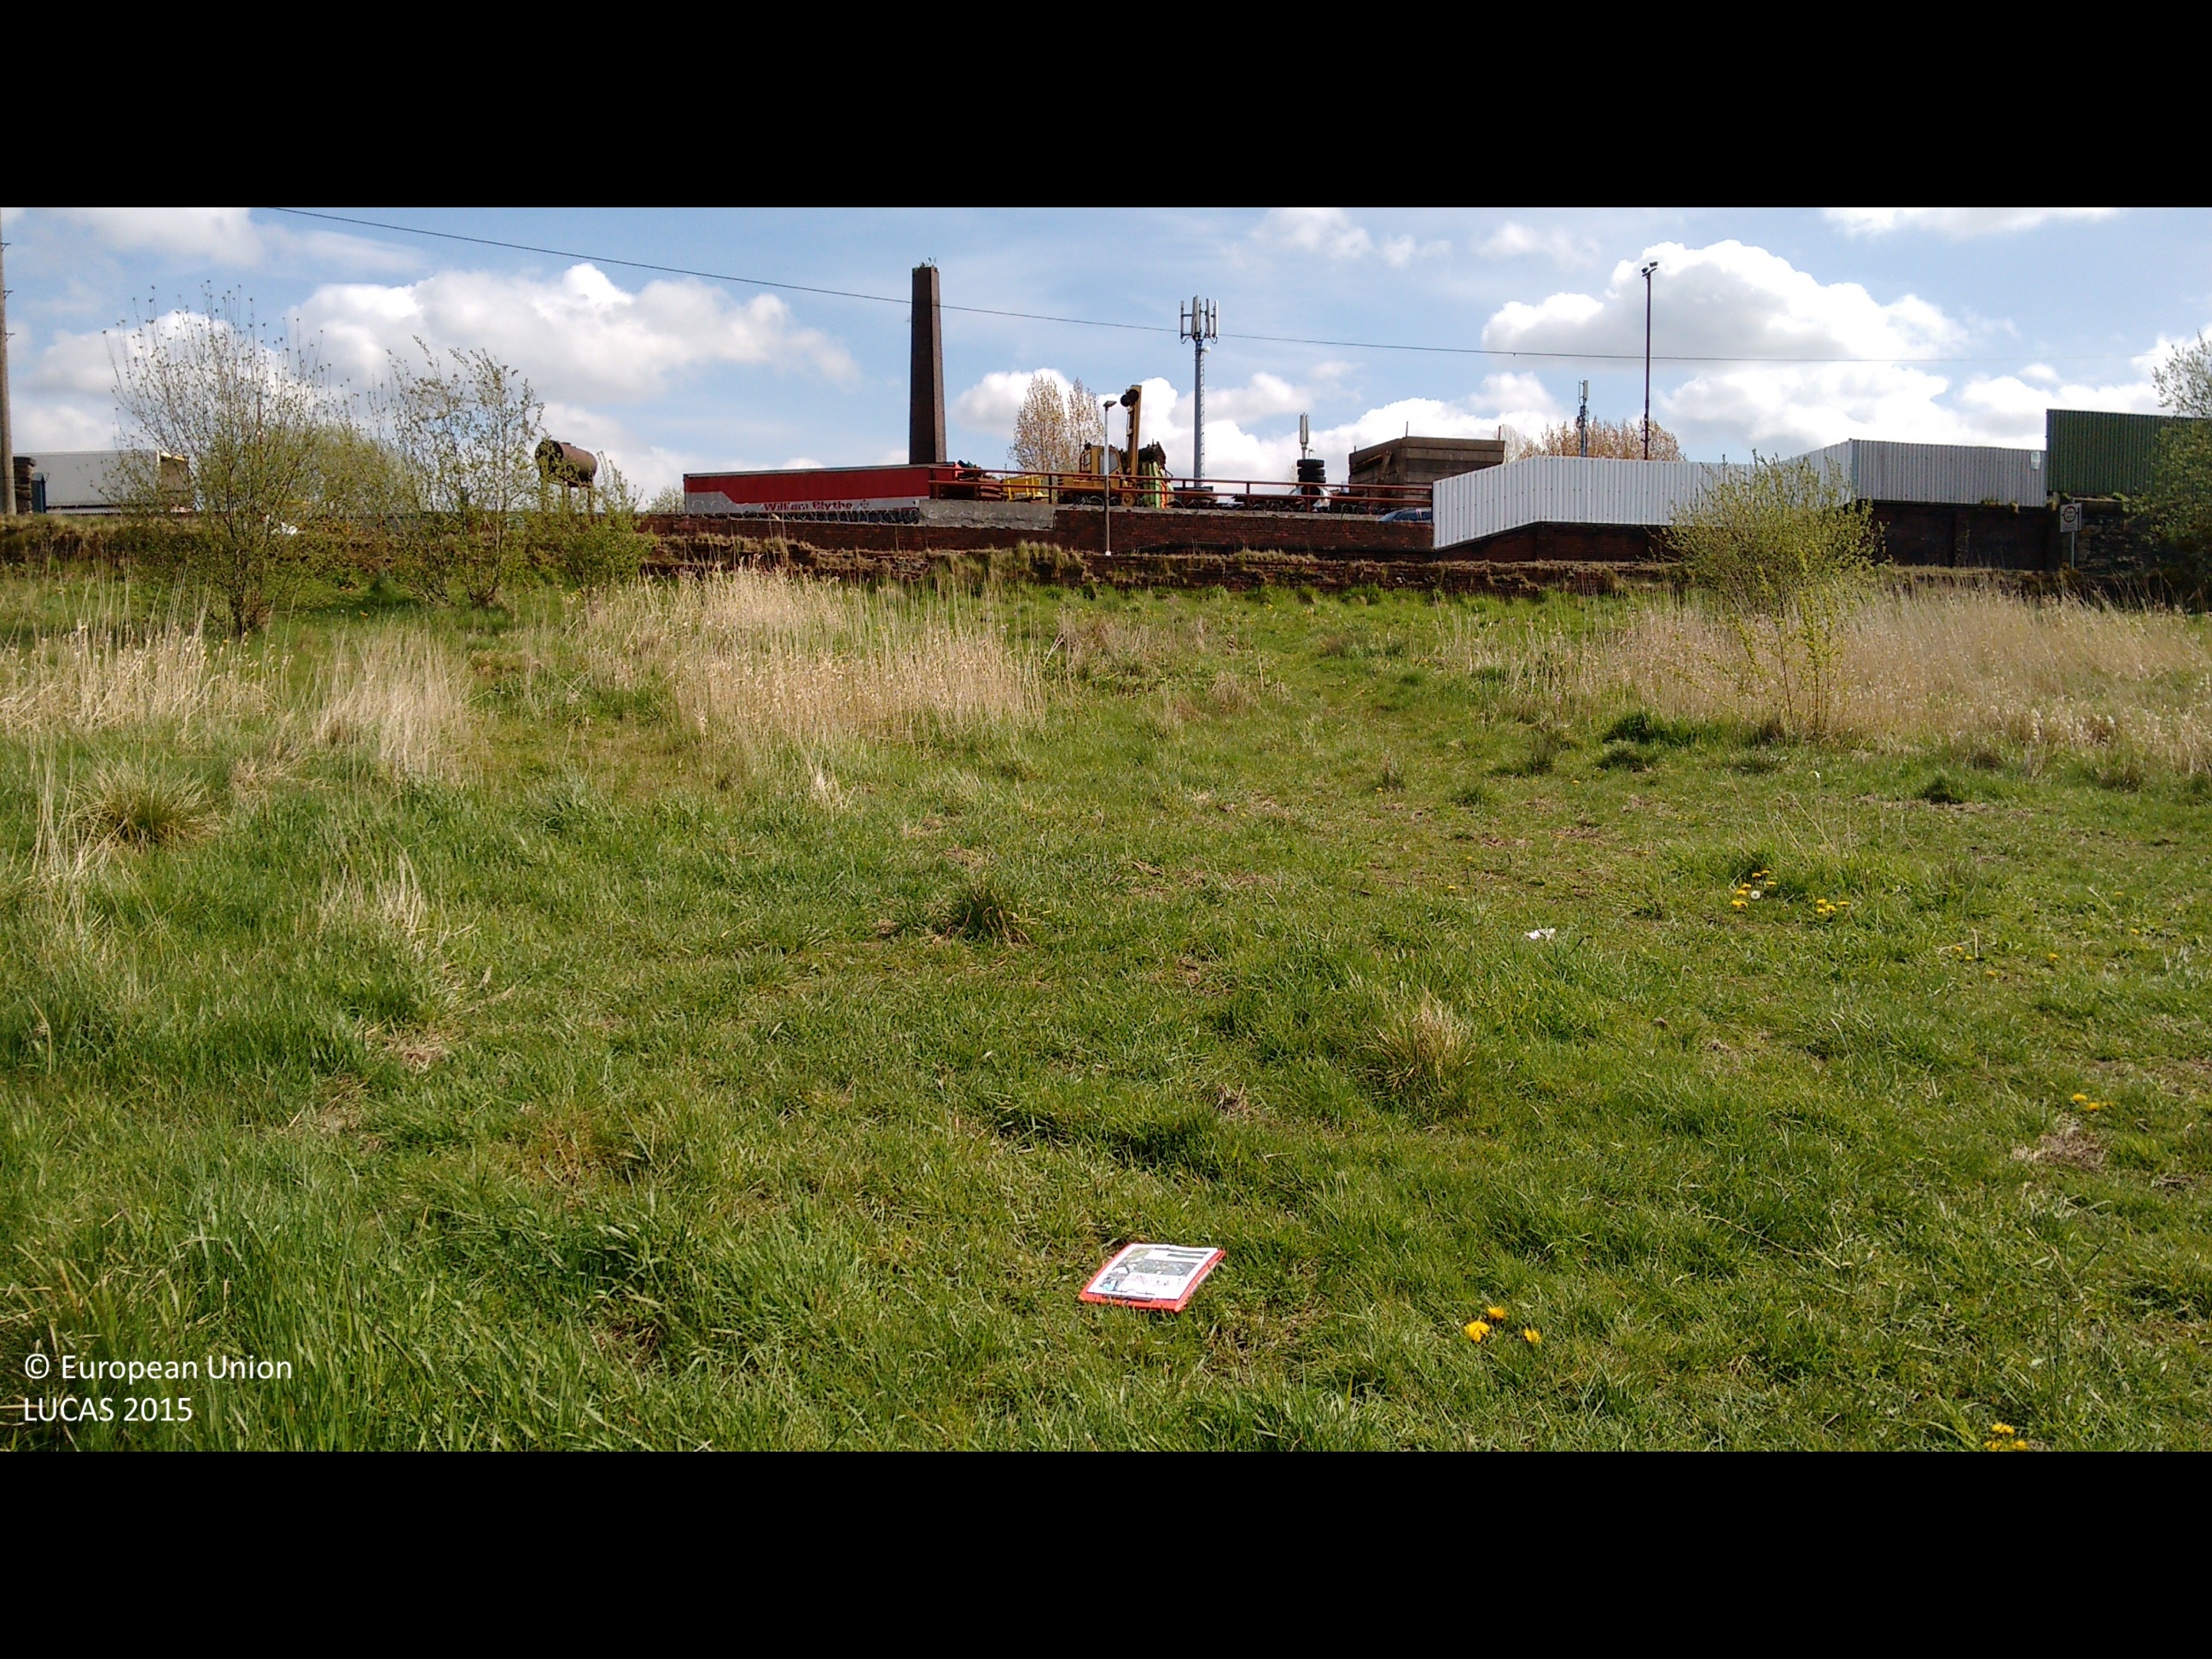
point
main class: Grassland
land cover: Grassland without tree/shrub cover
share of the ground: > 75 %
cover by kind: herbaceous plants 100 %
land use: Semi-natural and natural areas not in use
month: May
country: GB
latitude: 53.7008
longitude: -2.4702
